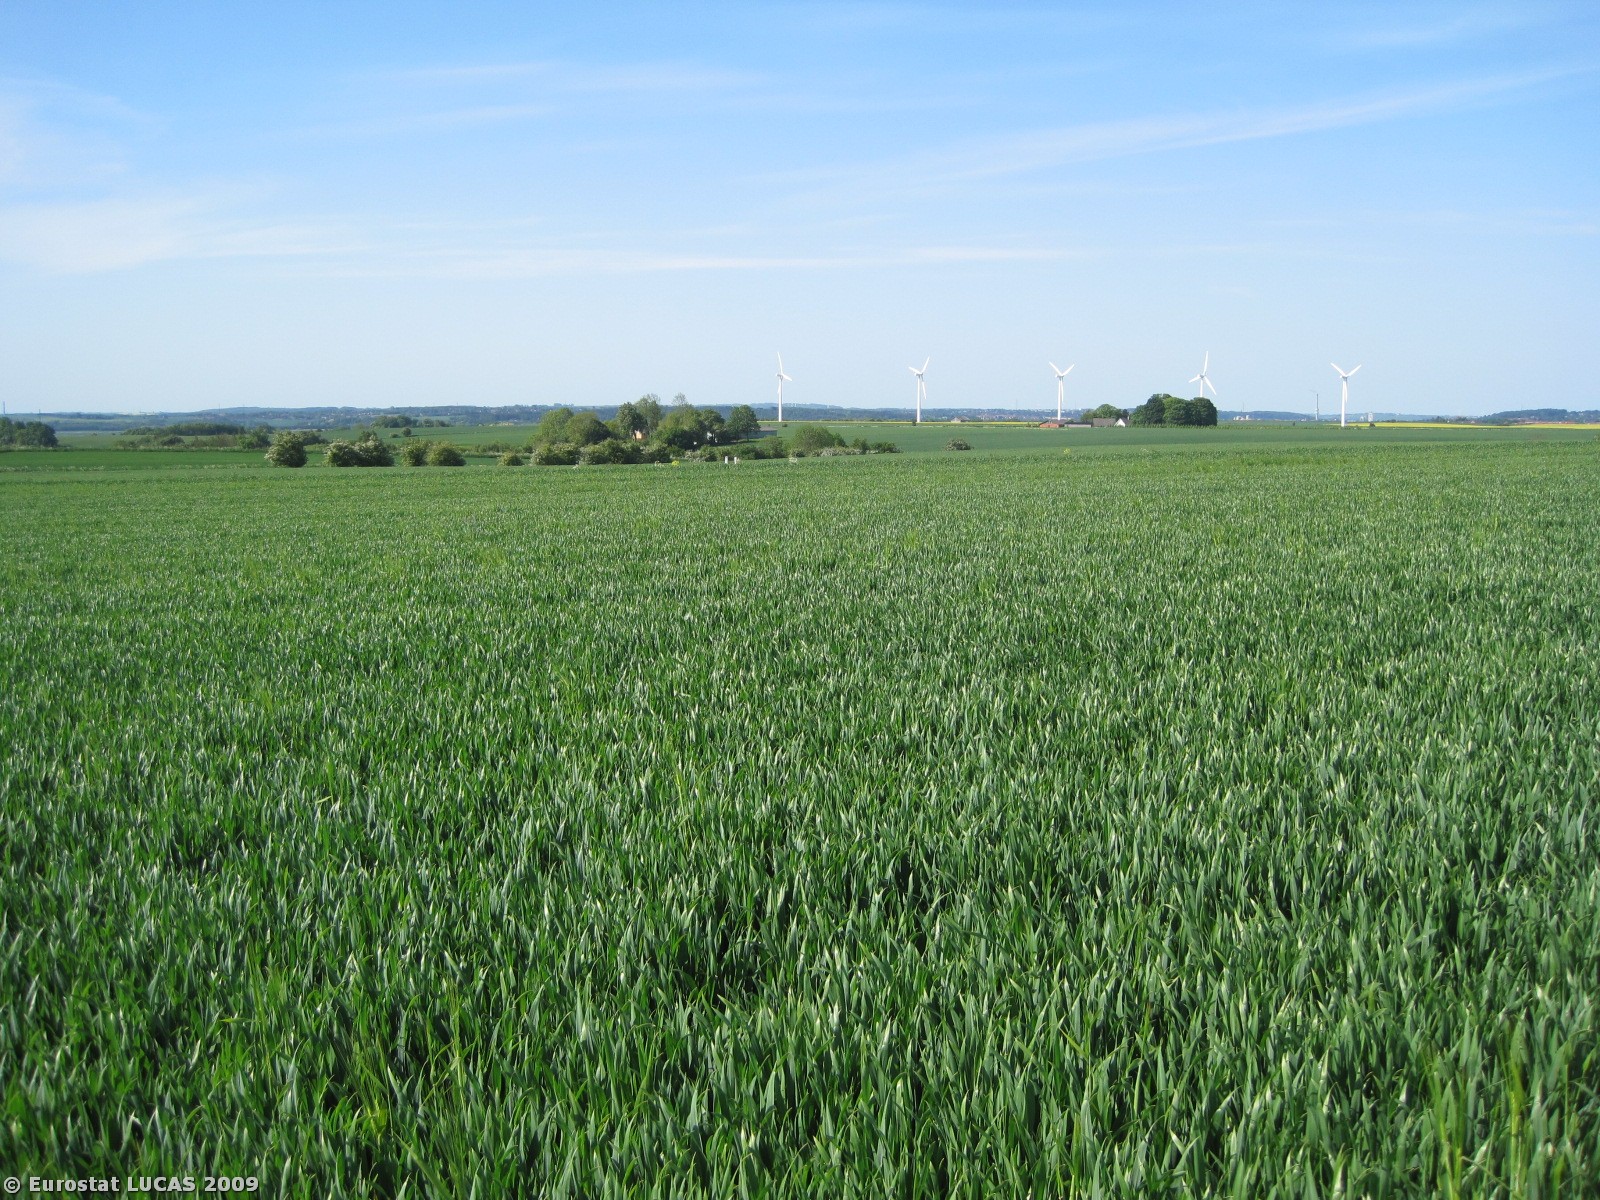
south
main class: Cropland
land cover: Common wheat
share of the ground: > 75 %
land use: Agriculture (excluding fallow land and kitchen gardens)
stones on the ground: < 10 %
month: May
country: DK
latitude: 56.4932
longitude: 10.1460
